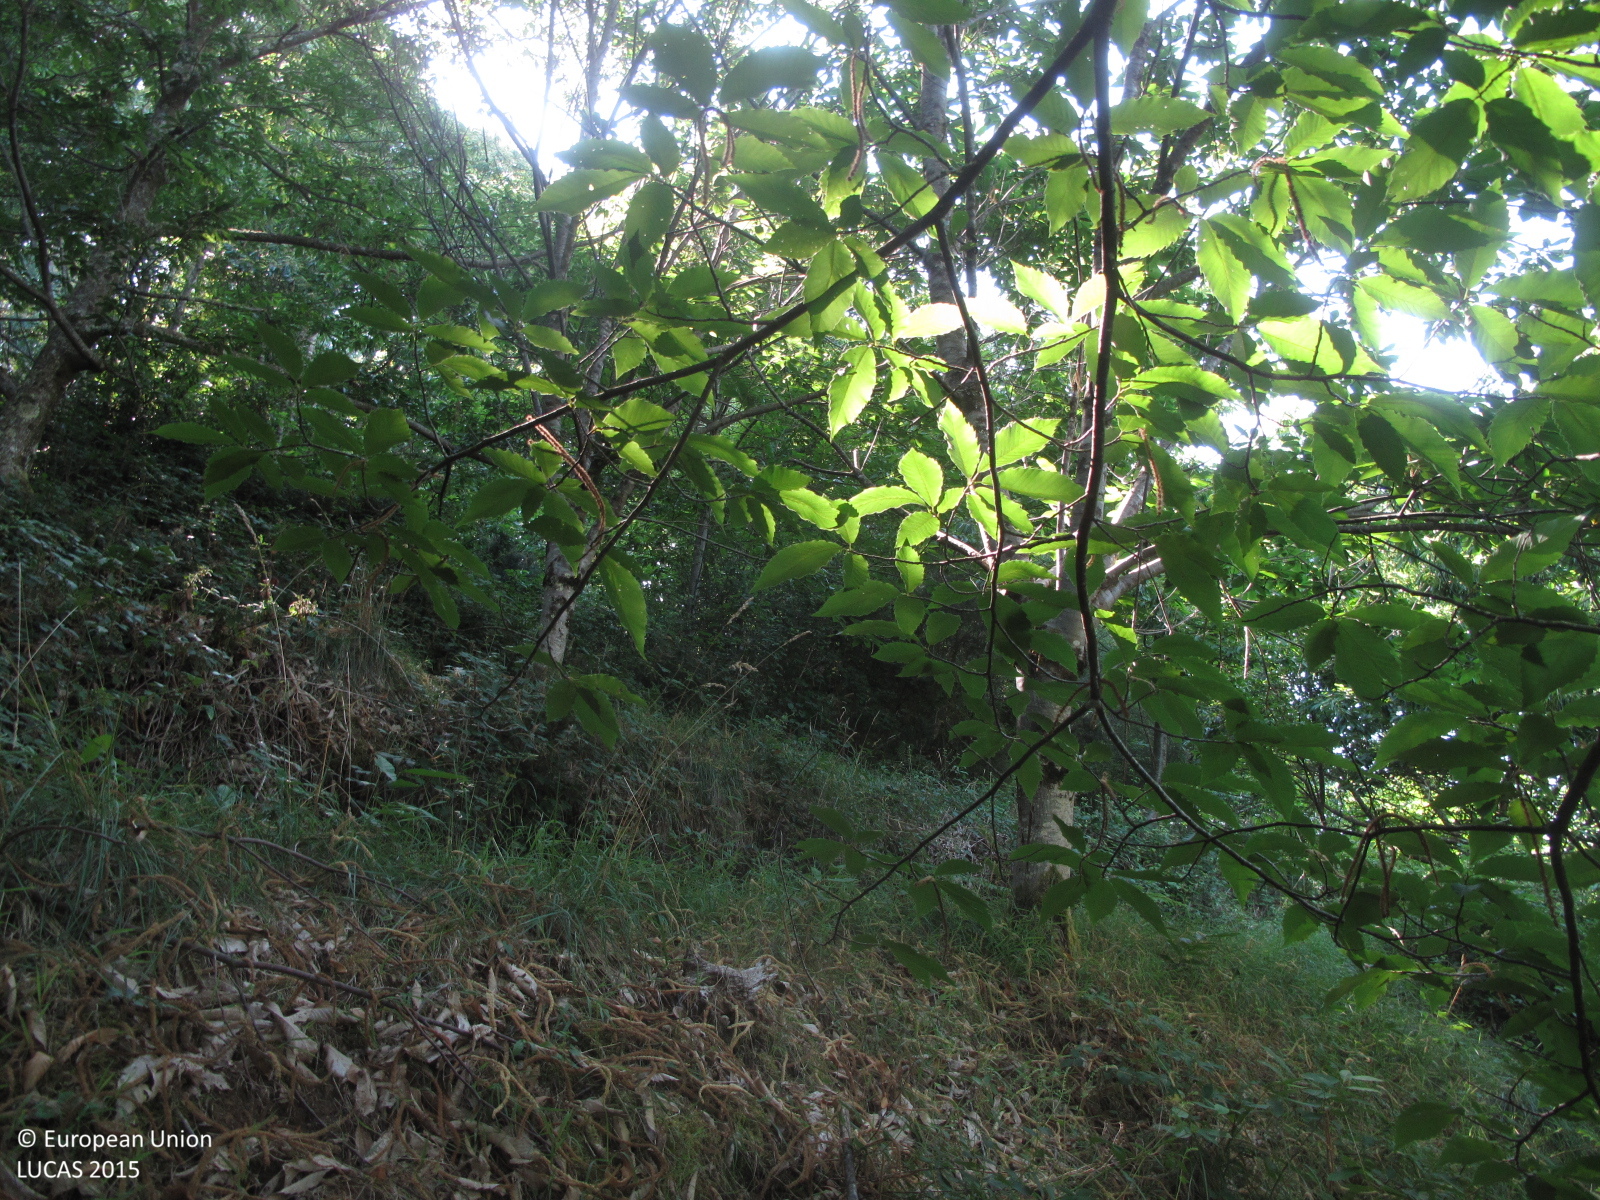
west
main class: Woodland
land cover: Broadleaved woodland
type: thermophilous deciduous forest
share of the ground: > 75 %
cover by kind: broadleaved forest trees 100 %
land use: Forestry
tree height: > 5 m
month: July
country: ES
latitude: 43.3213
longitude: -8.1640
